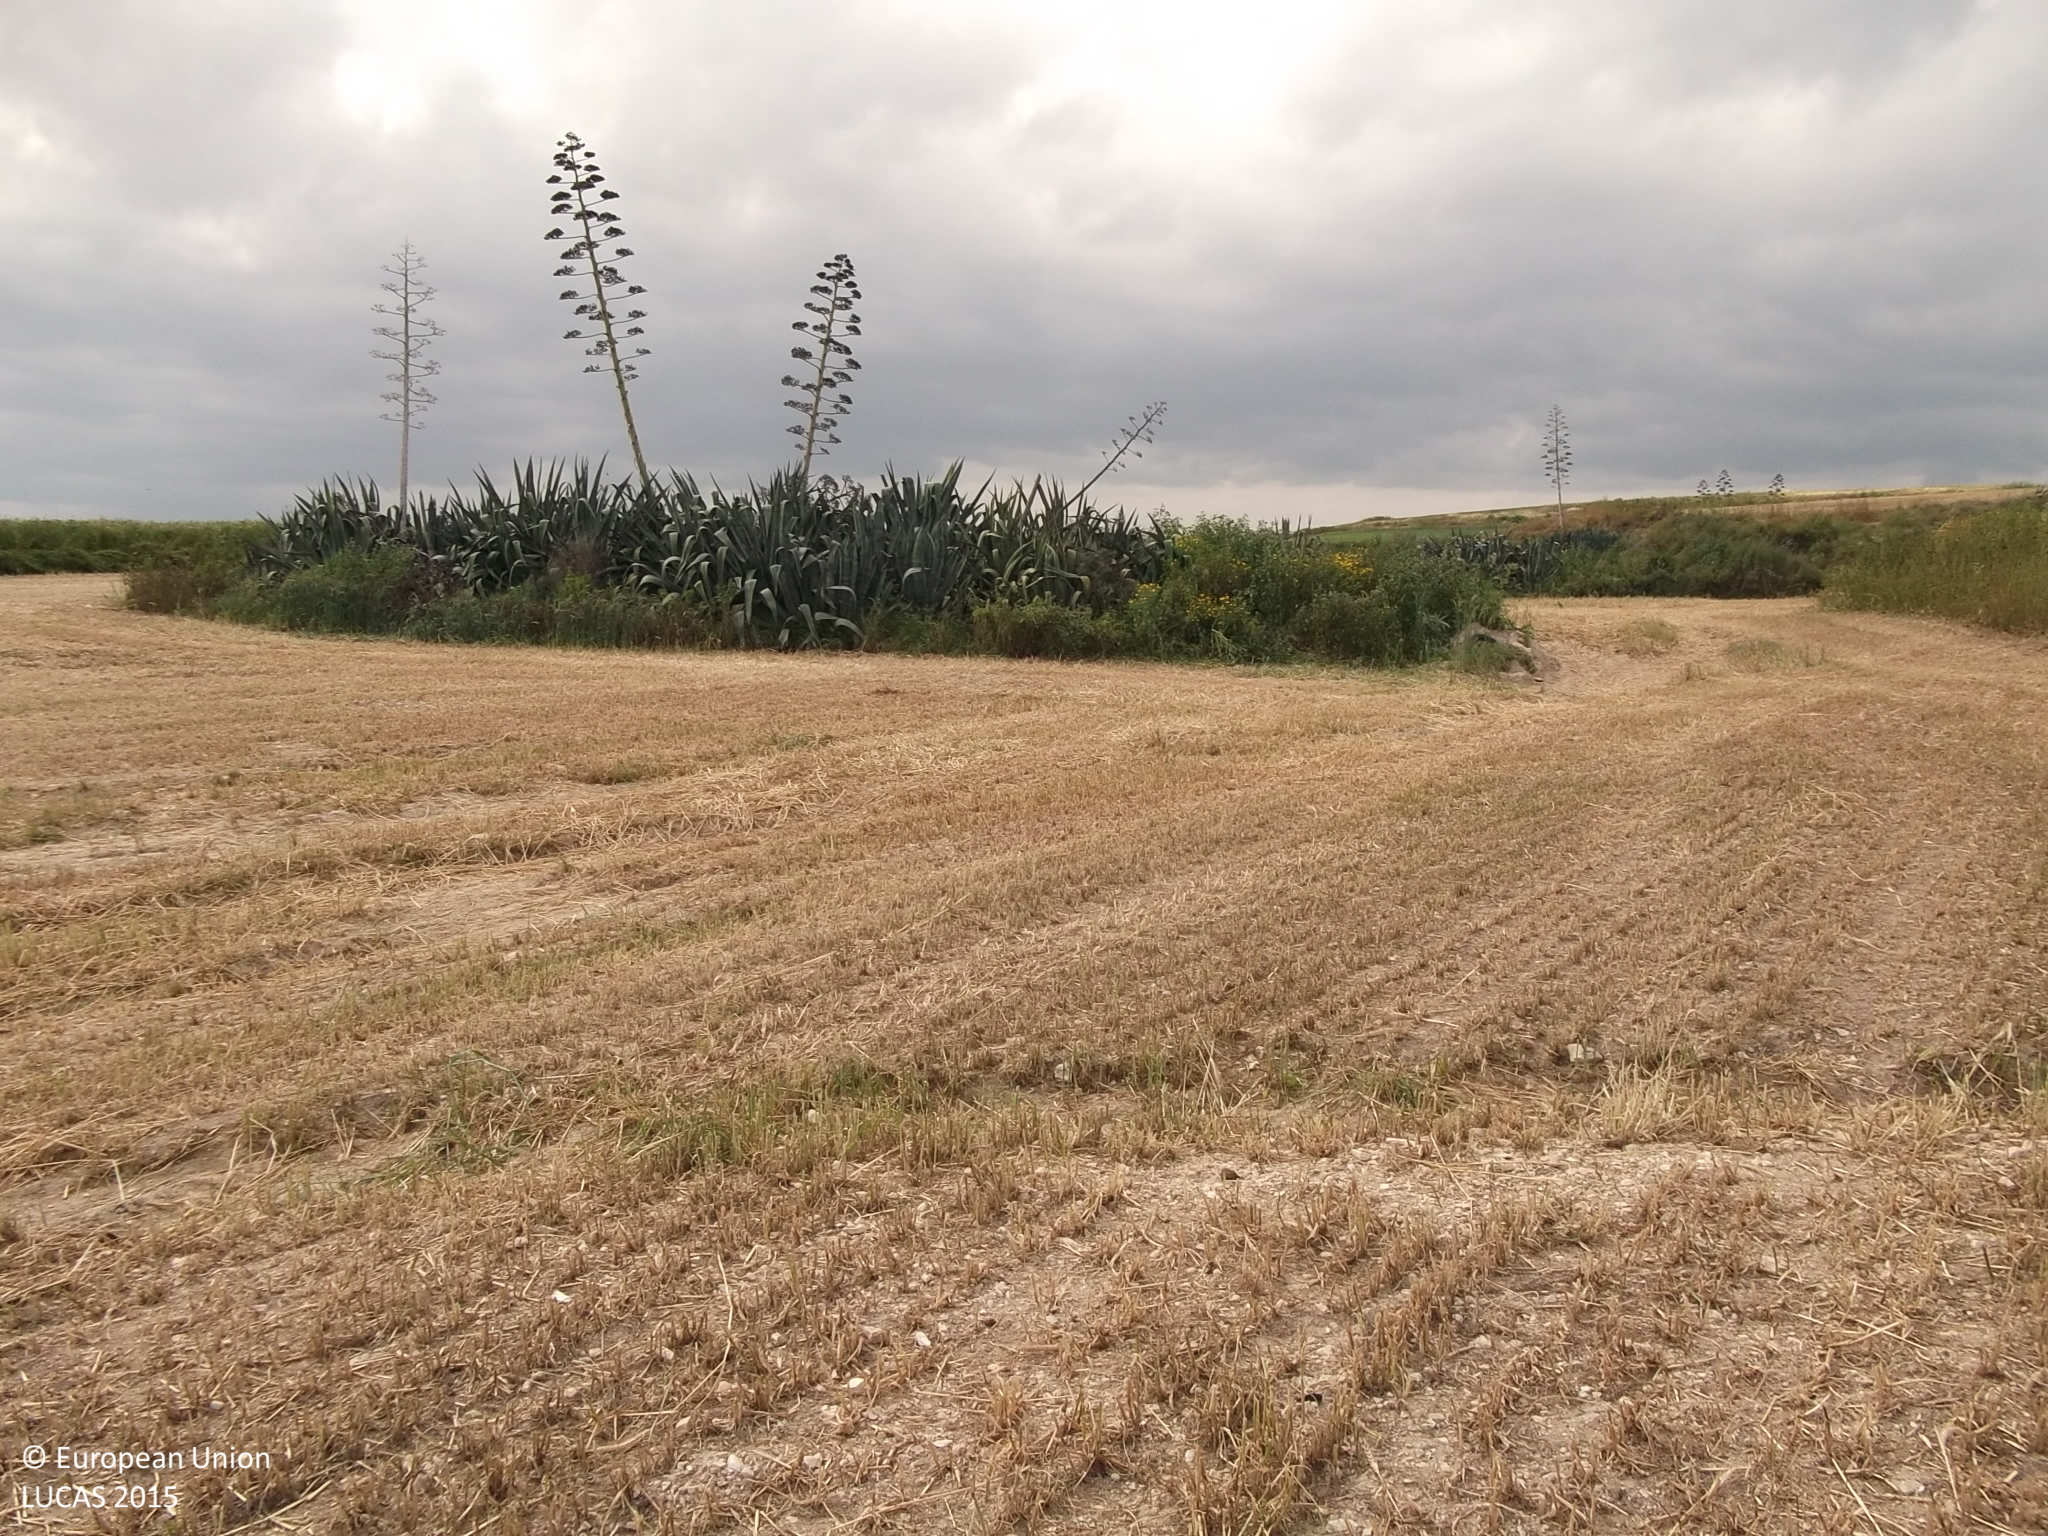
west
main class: Cropland
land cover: Common wheat
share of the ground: 10 - 25 %
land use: Agriculture (excluding fallow land and kitchen gardens)
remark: Harvested field
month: April
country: CY
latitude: 34.9751
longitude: 33.6049
